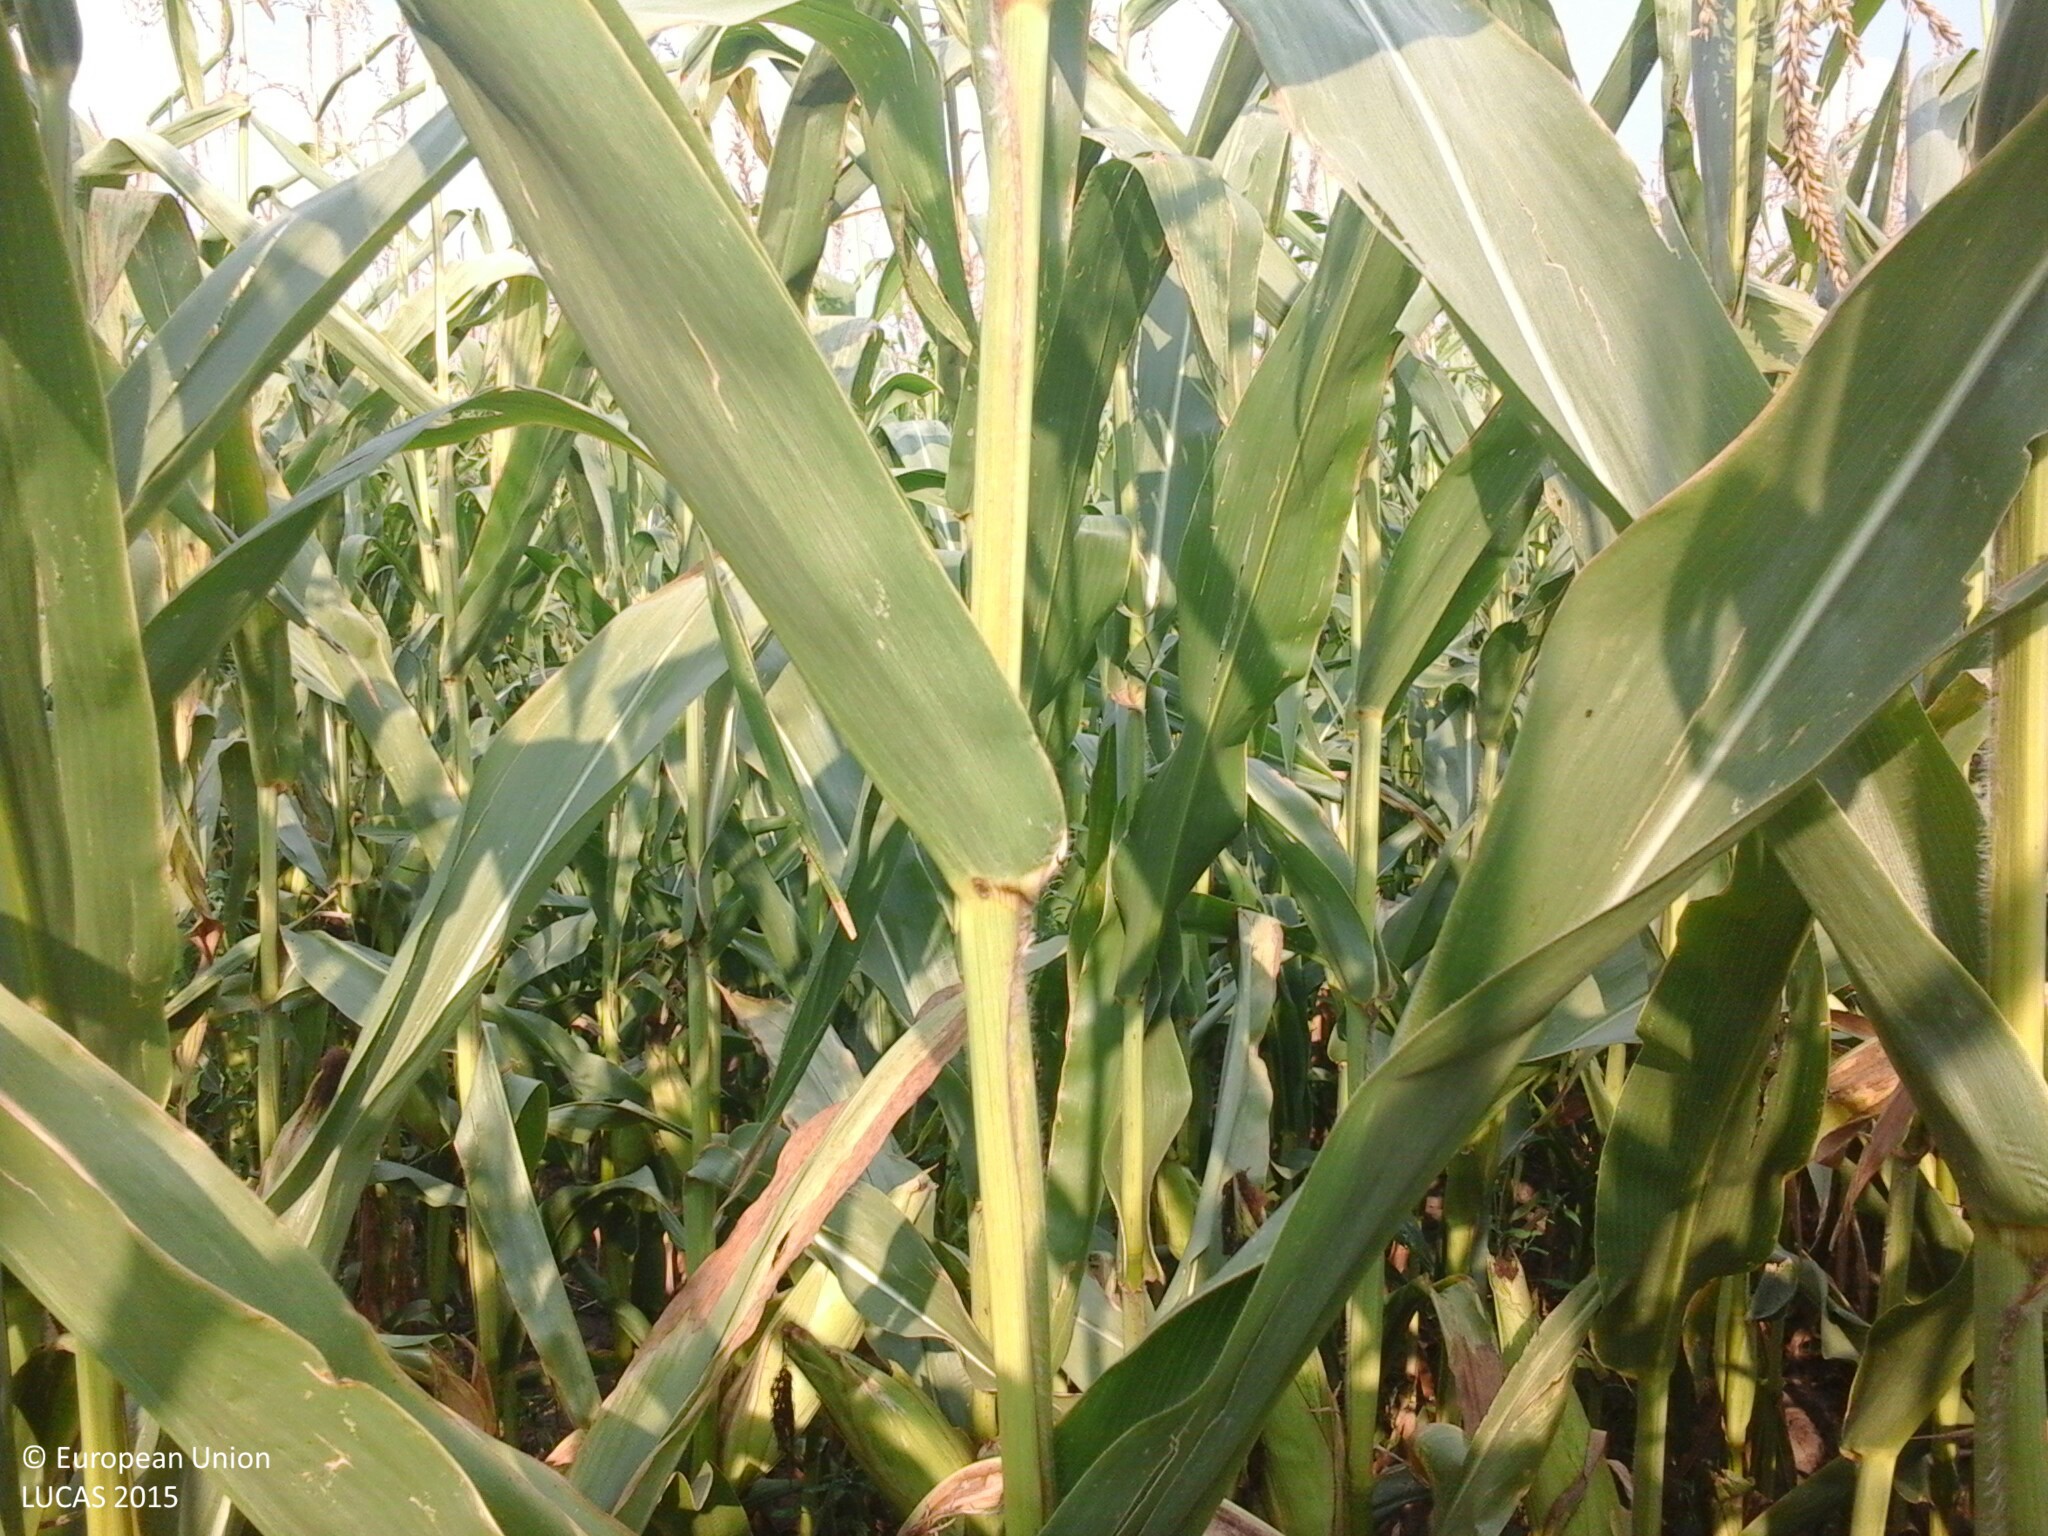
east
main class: Cropland
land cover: Maize
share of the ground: > 75 %
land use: Agriculture (excluding fallow land and kitchen gardens)
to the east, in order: Maize; Electric lines; Maize; Grass margins; Tracks; Grass margins; Maize
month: August
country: HU
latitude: 46.8517
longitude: 18.4178
